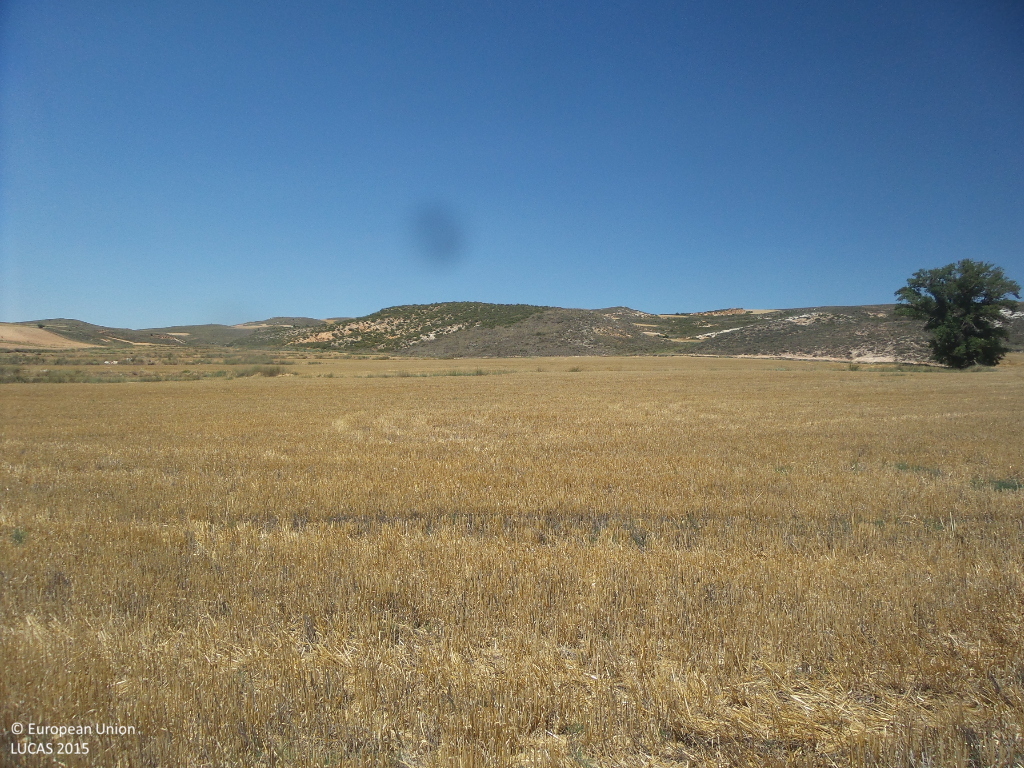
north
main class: Cropland
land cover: Barley
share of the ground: < 10 %
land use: Agriculture (excluding fallow land and kitchen gardens)
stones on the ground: < 10 %
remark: Harvested field
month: July
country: ES
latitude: 41.4325
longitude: -2.1053
